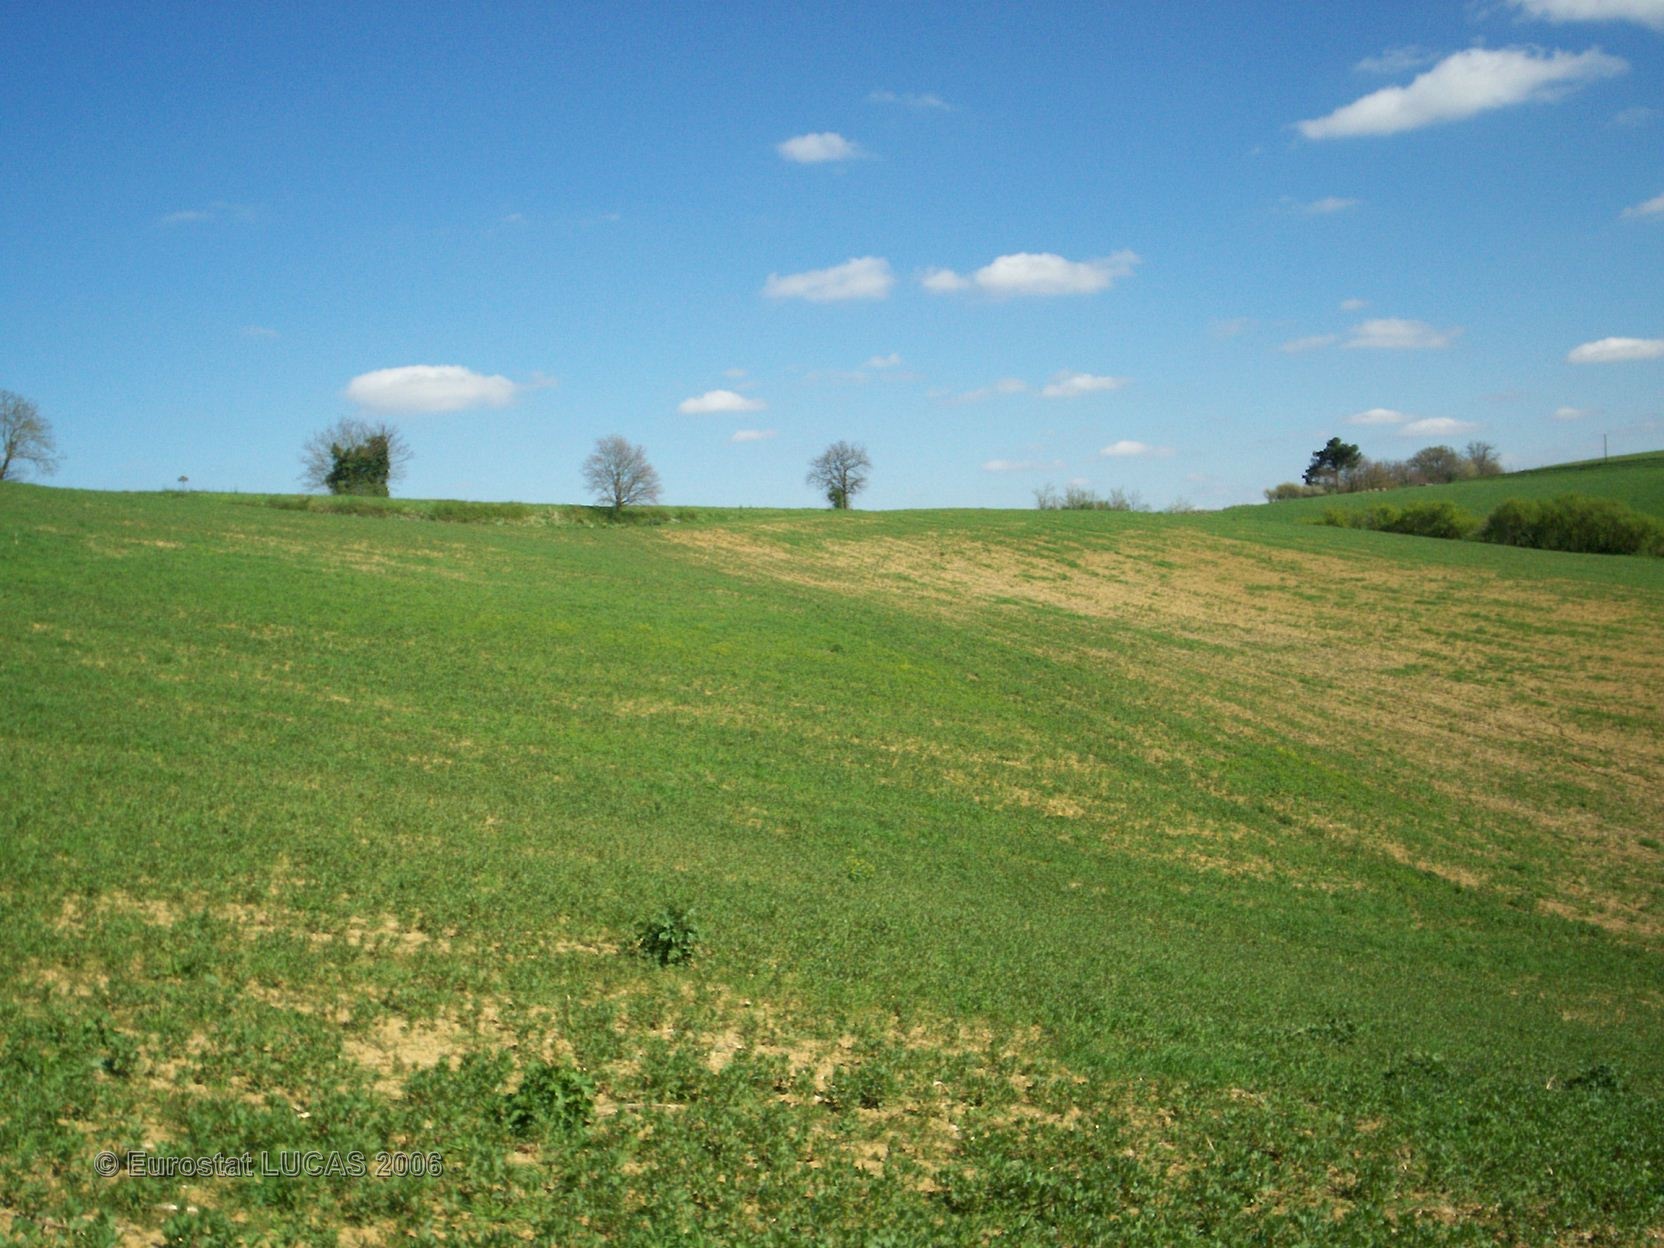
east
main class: Cropland
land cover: Dry pulses
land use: Agriculture (excluding fallow land and kitchen gardens)
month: April
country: FR
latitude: 43.5436
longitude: 0.2311
